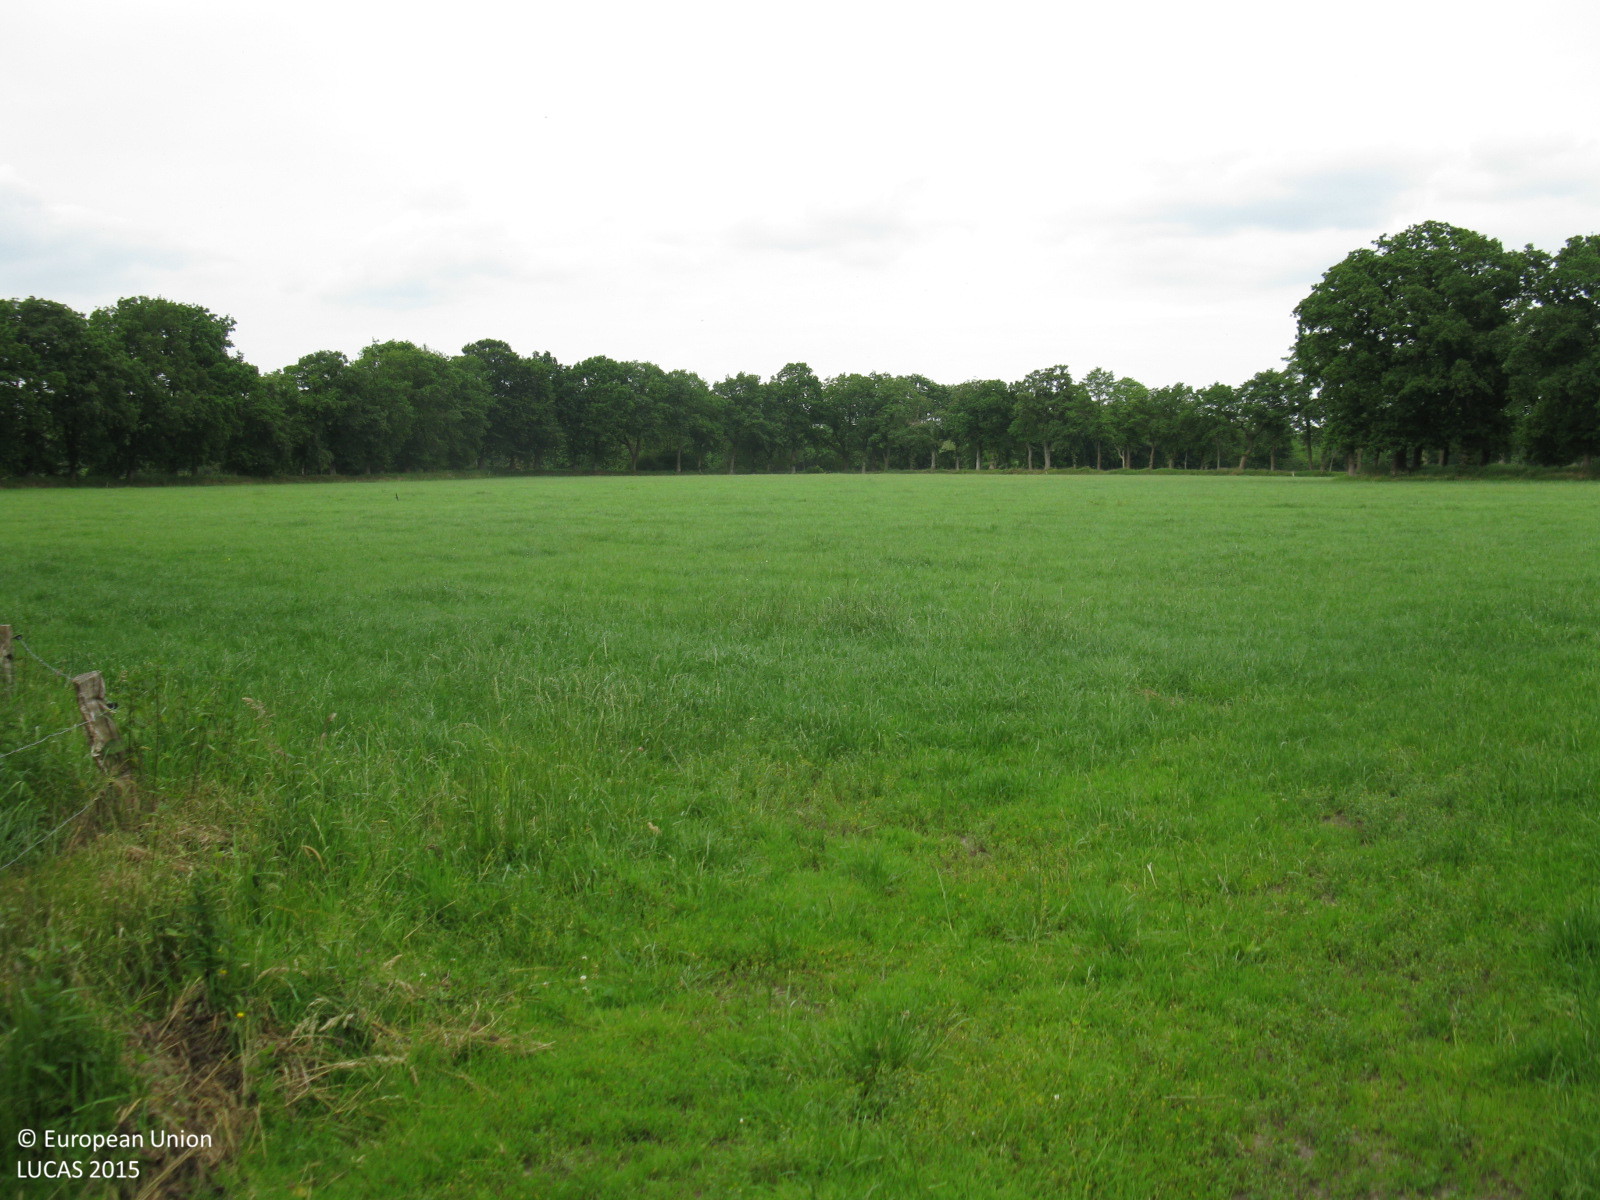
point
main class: Grassland
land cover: Grassland without tree/shrub cover
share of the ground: > 75 %
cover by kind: herbaceous plants 100 %
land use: Agriculture (excluding fallow land and kitchen gardens)
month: June
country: DE
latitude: 53.5091
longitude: 7.8746
